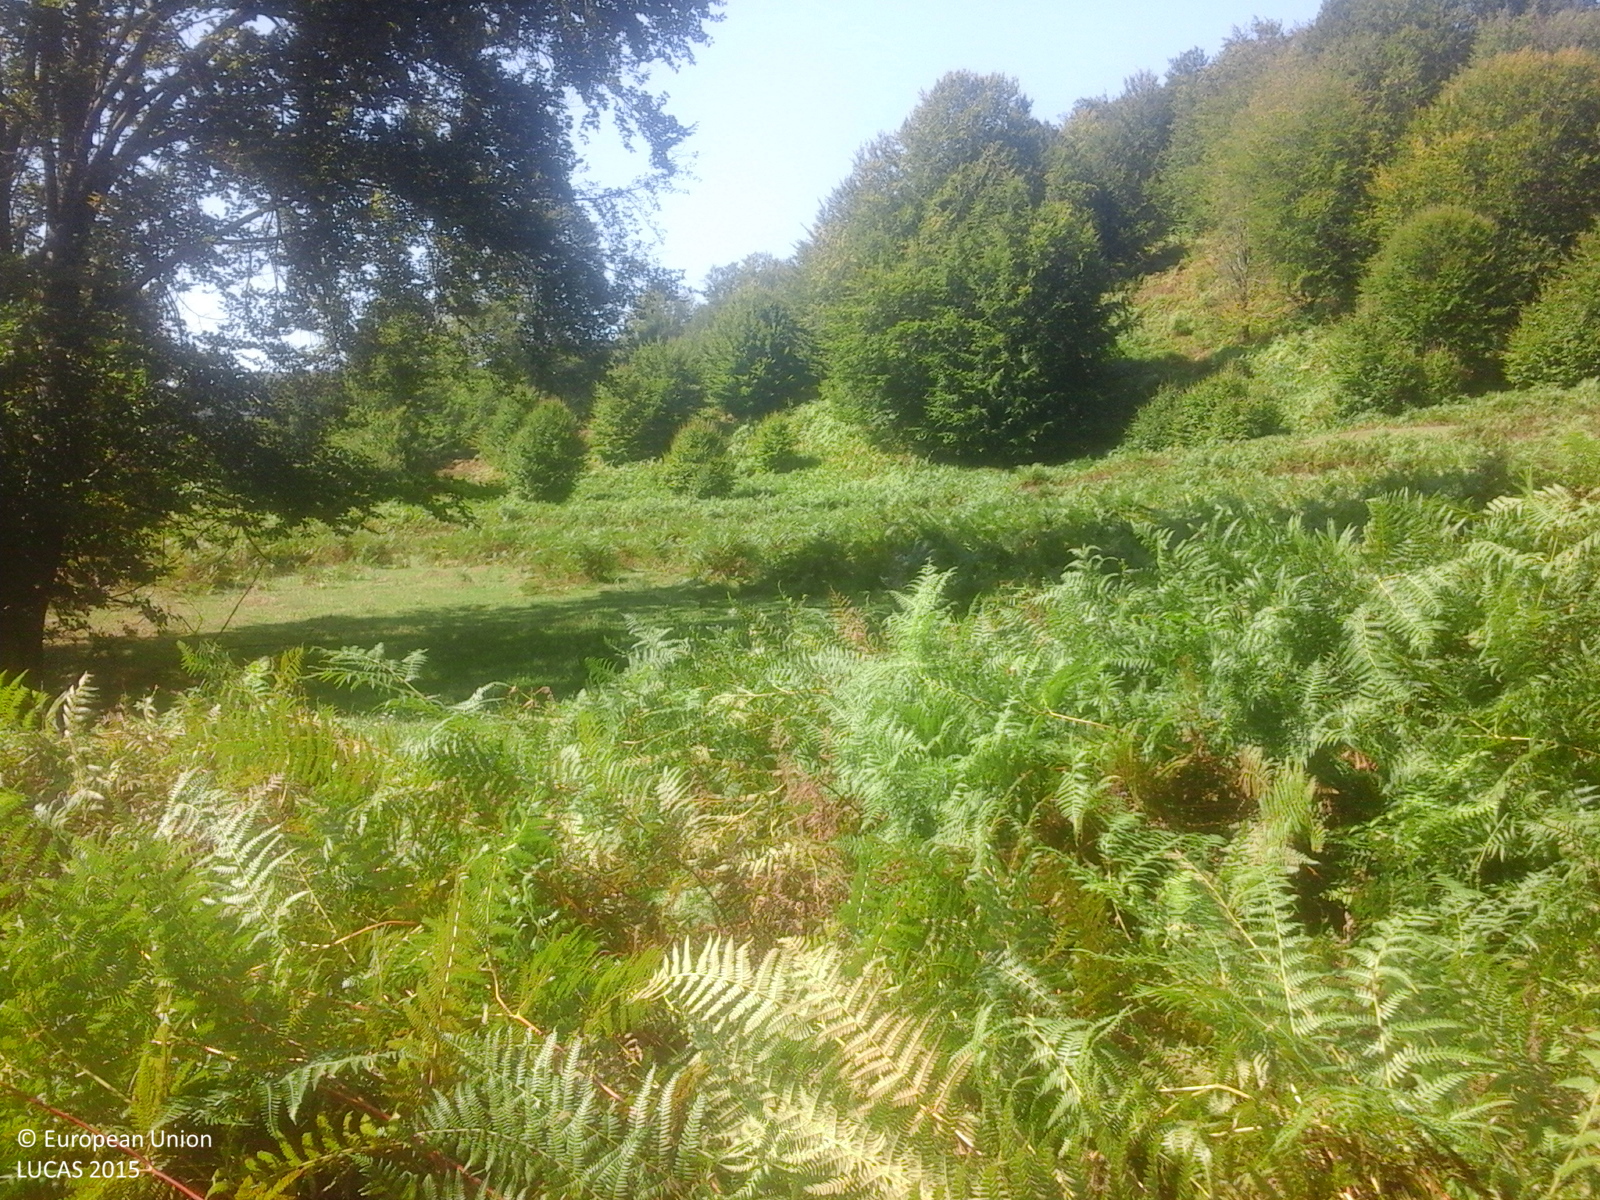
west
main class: Grassland
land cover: Spontaneously vegetated surfaces
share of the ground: > 75 %
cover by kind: herbaceous plants 100 %
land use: Semi-natural and natural areas not in use
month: September
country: RO
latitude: 46.8238
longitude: 22.4396
